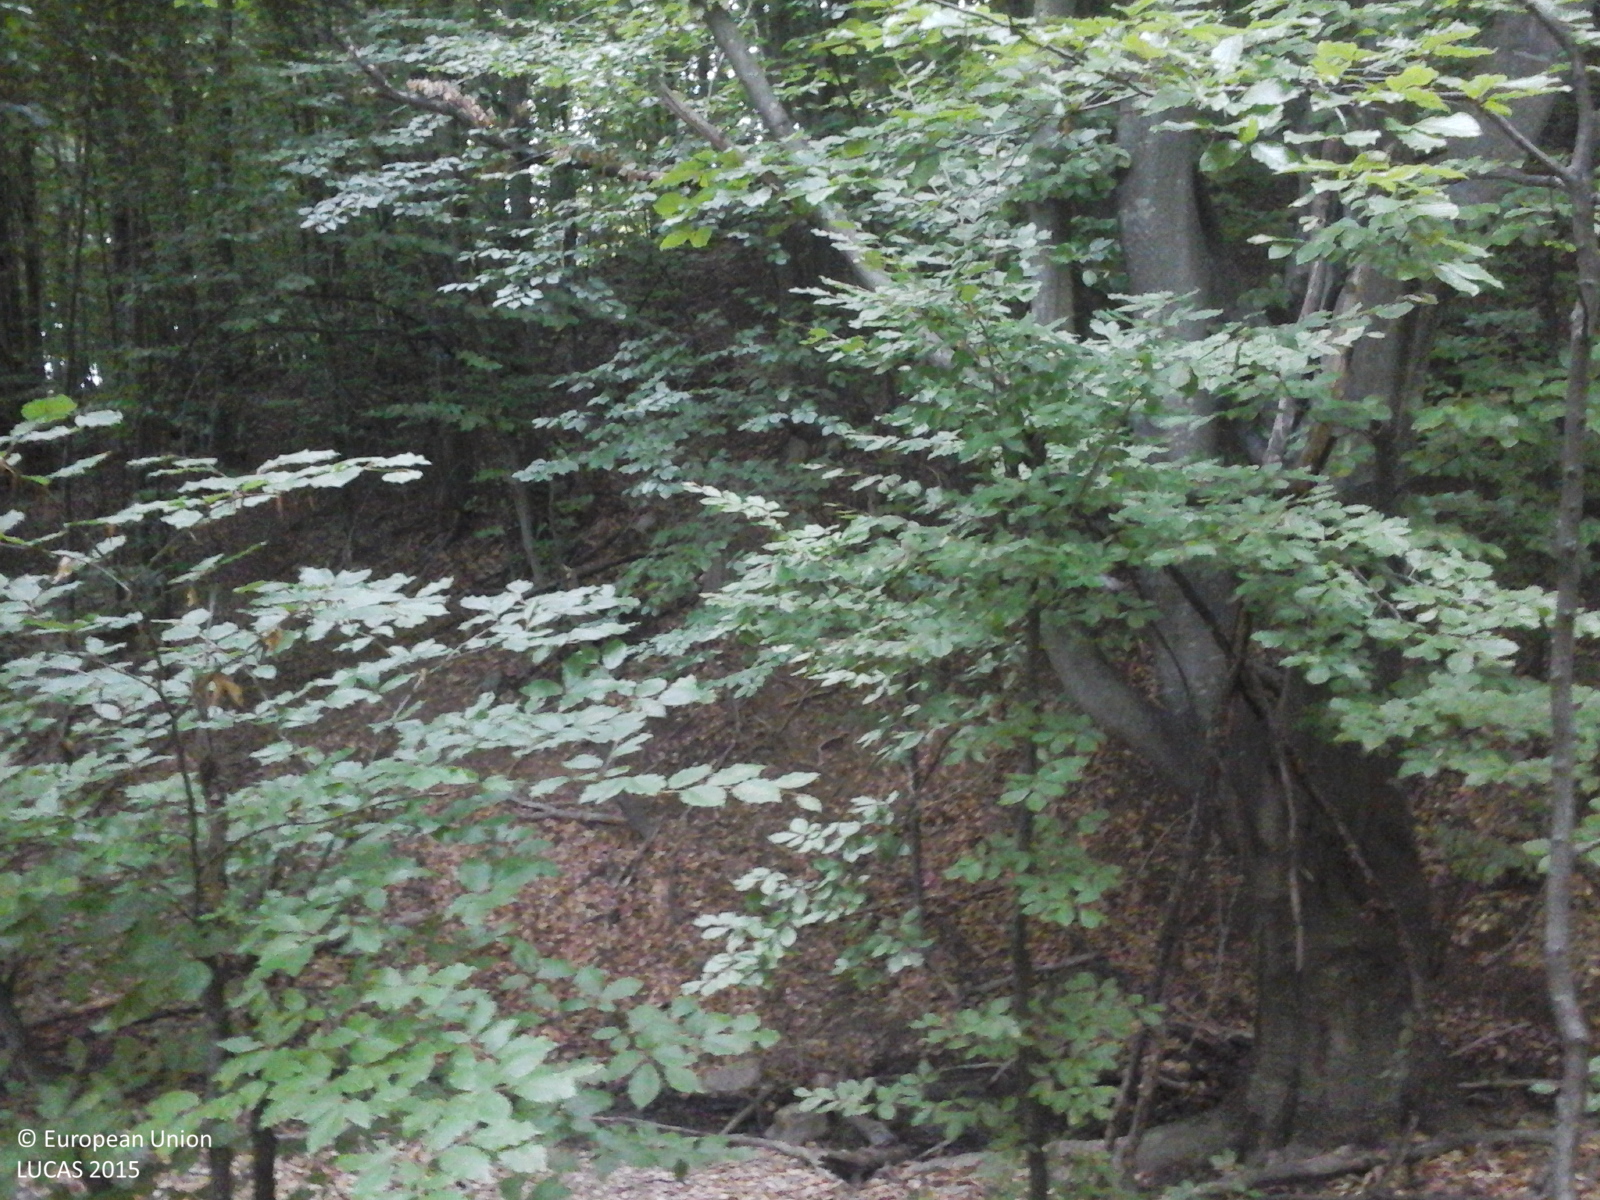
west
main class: Woodland
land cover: Broadleaved woodland
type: beech forest
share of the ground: > 75 %
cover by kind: broadleaved forest trees 100 %
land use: Forestry
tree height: > 5 m
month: September
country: RO
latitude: 47.8262
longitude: 23.5004
